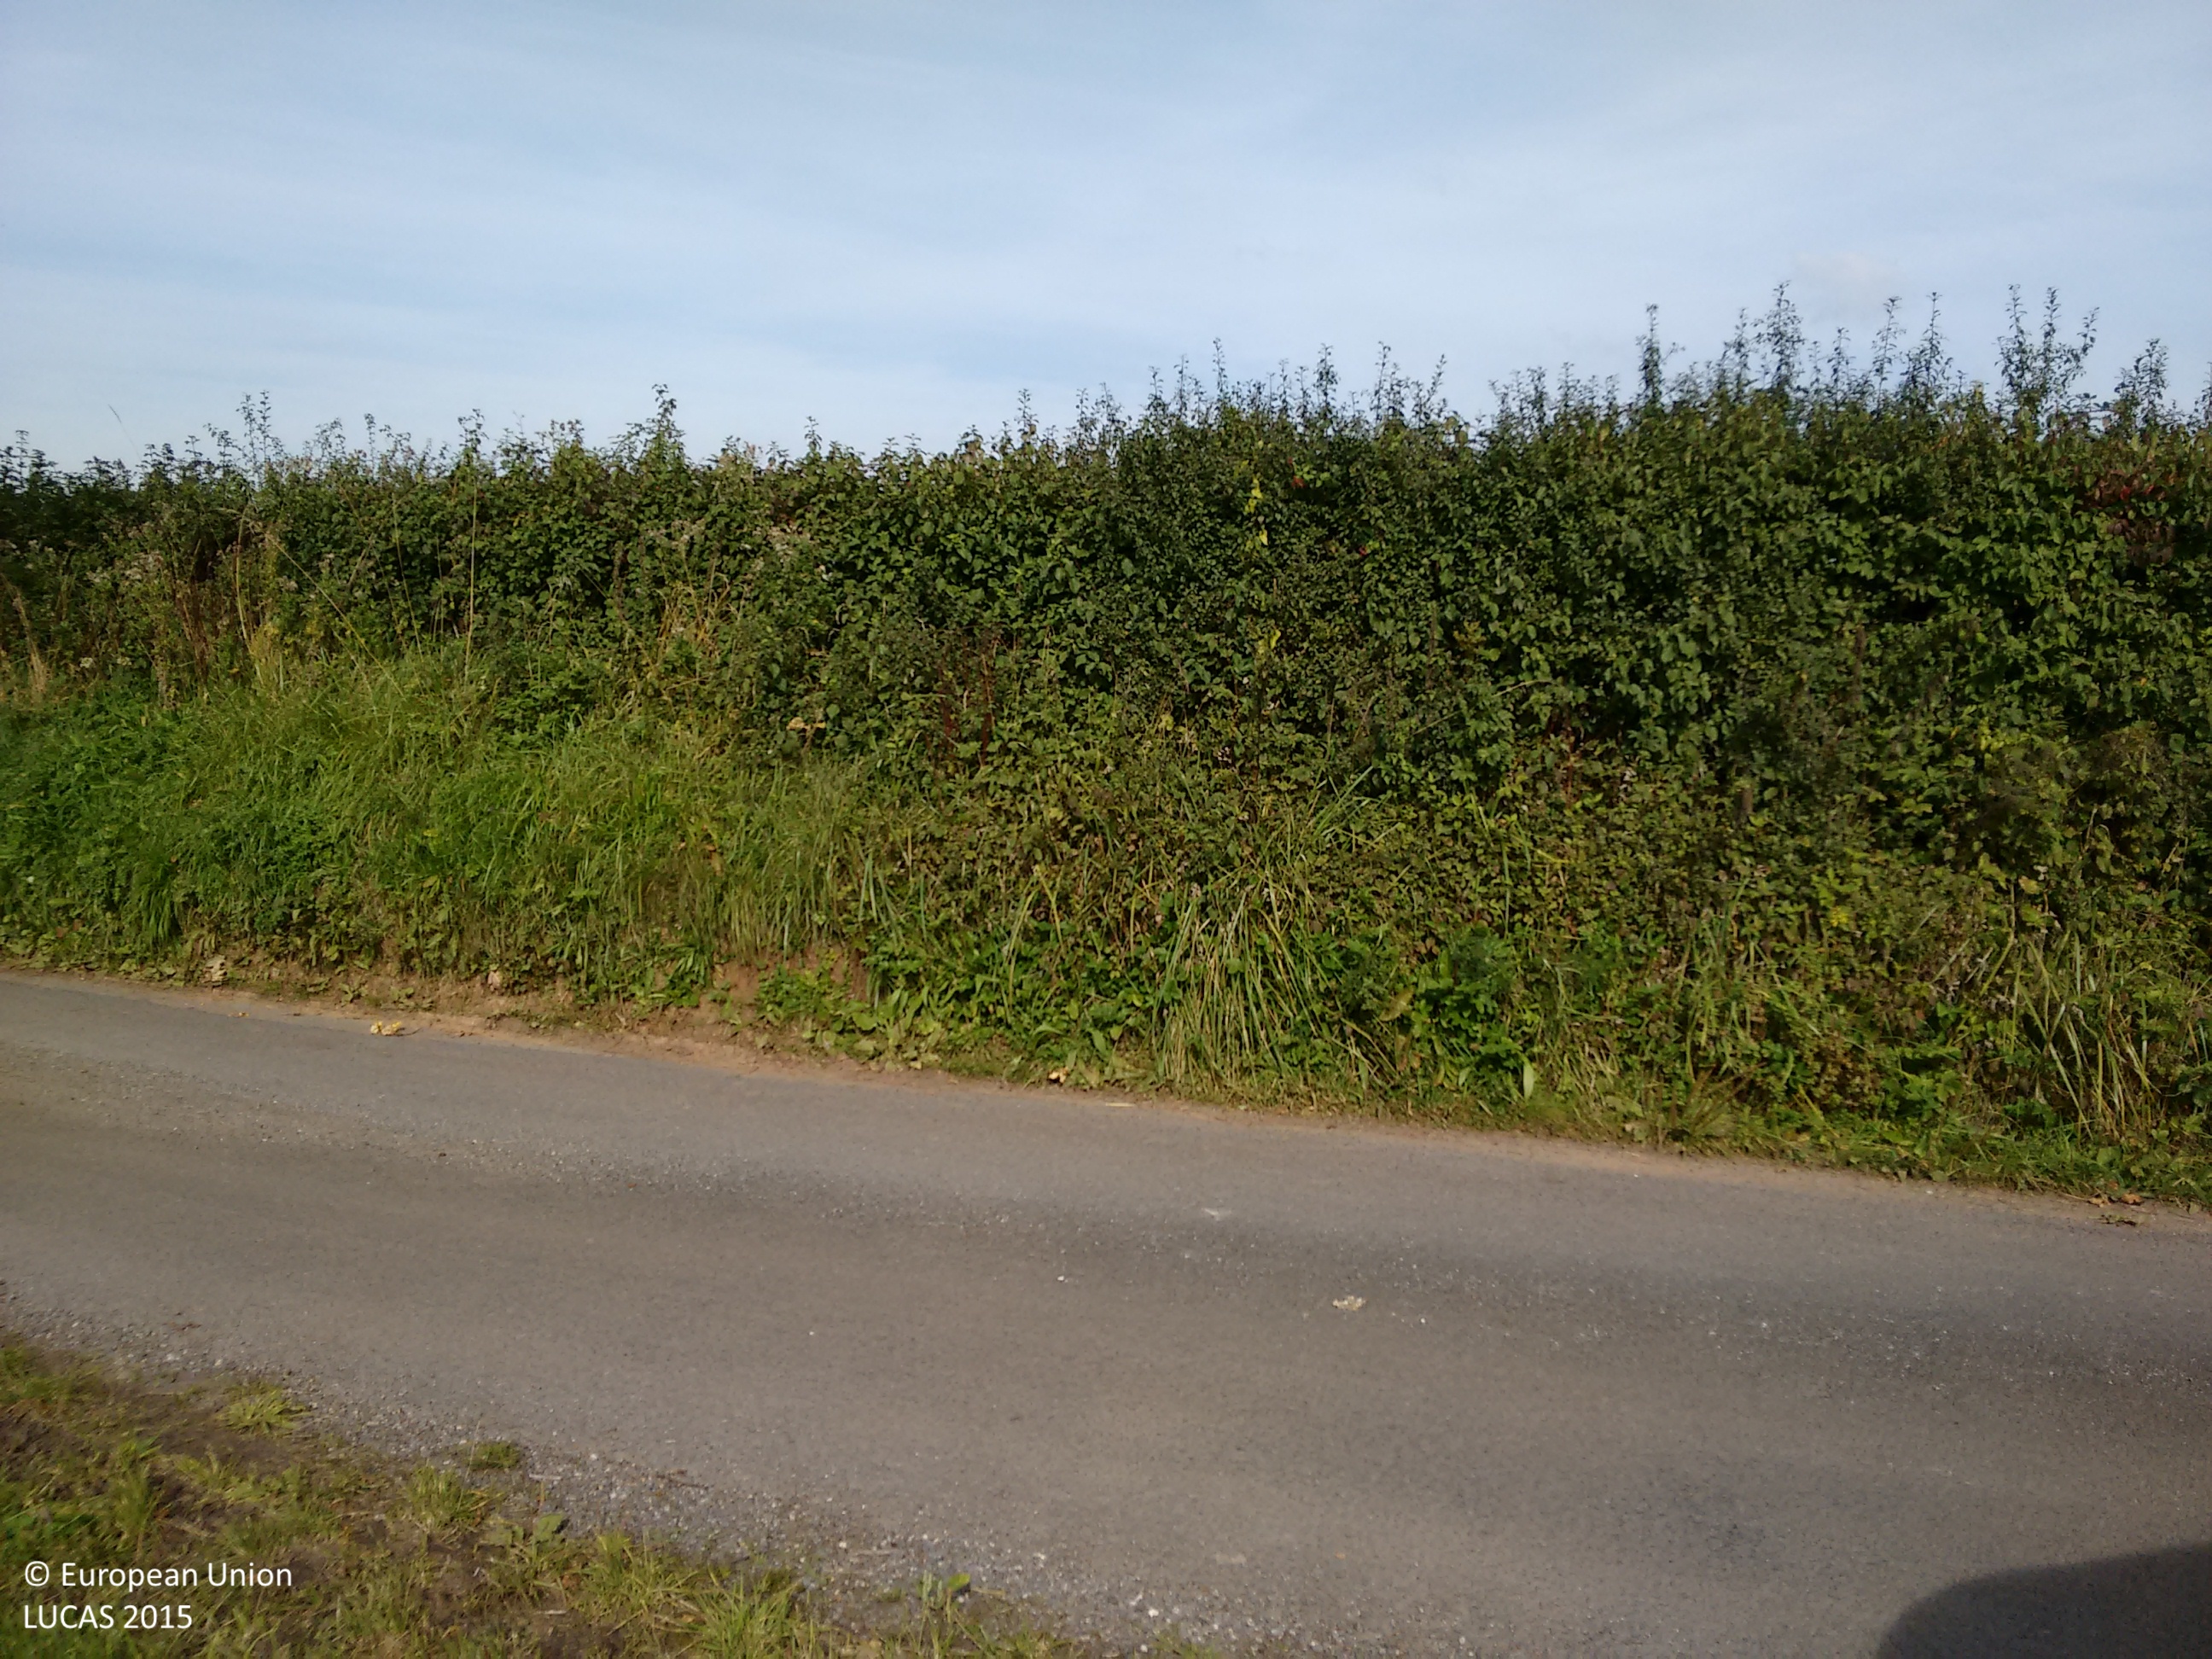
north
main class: Grassland
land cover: Grassland without tree/shrub cover
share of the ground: > 75 %
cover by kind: herbaceous plants 100 %
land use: Road transport
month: September
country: GB
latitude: 51.6667
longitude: -2.4272
